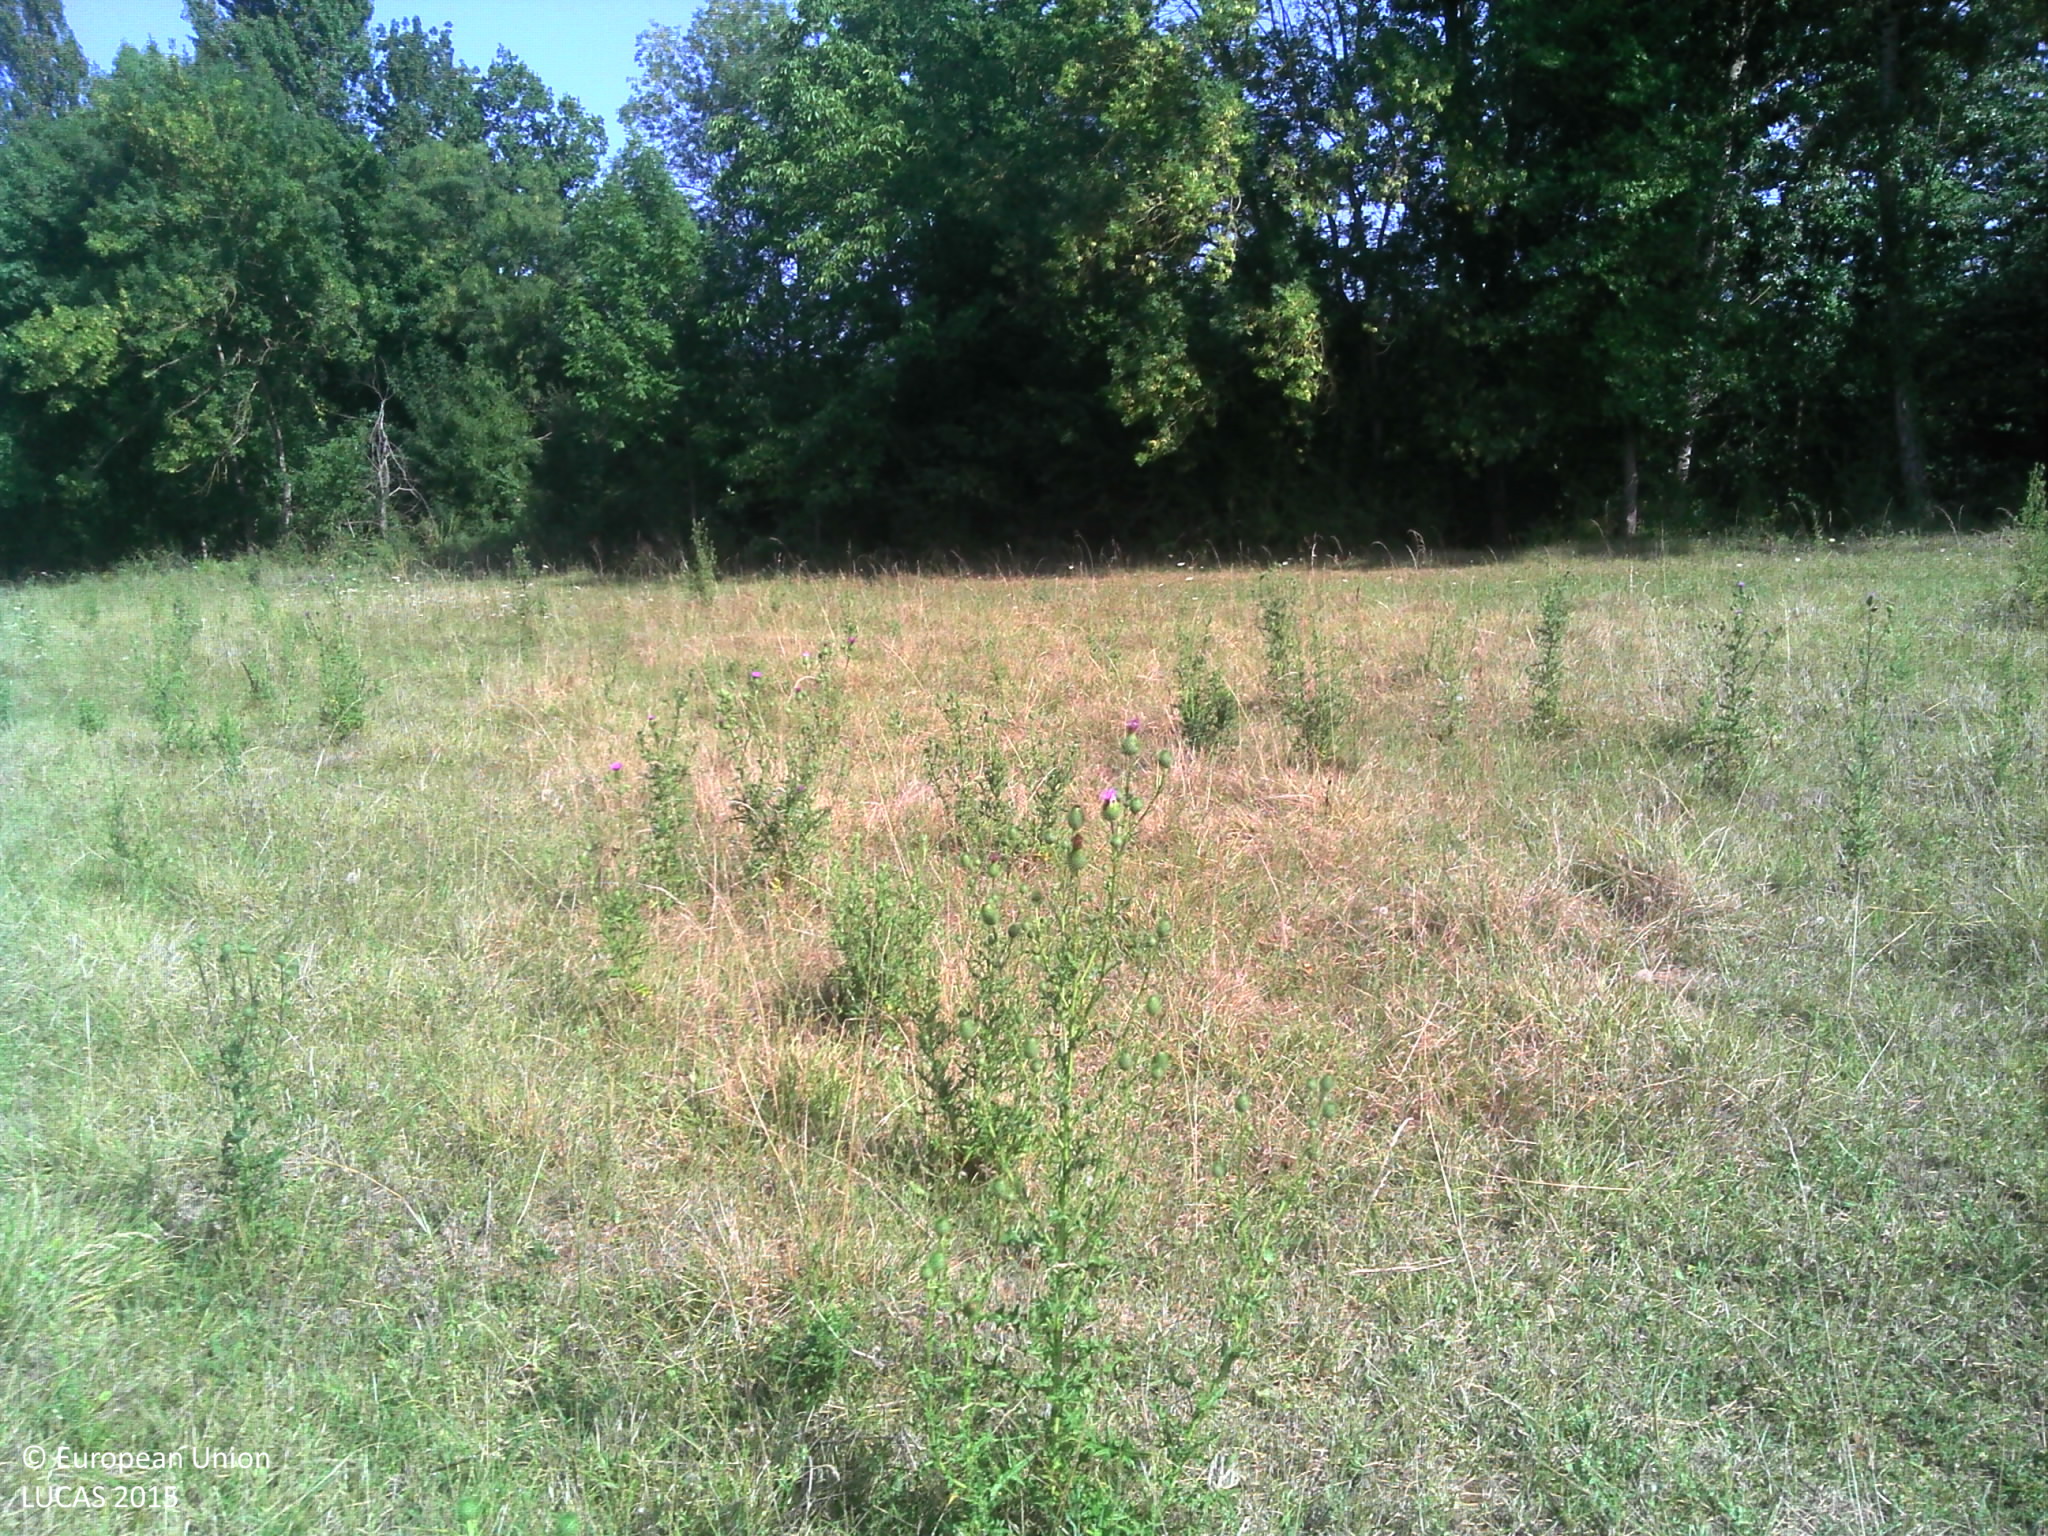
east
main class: Grassland
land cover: Grassland without tree/shrub cover
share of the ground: > 75 %
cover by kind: herbaceous plants 100 %
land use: Agriculture (excluding fallow land and kitchen gardens)
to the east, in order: Grassland without tree/shrub cover; Lines of trees; Ponds and wetlands; Lines of trees; Grass margins; Maize
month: August
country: FR
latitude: 44.1666
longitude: 1.3073
